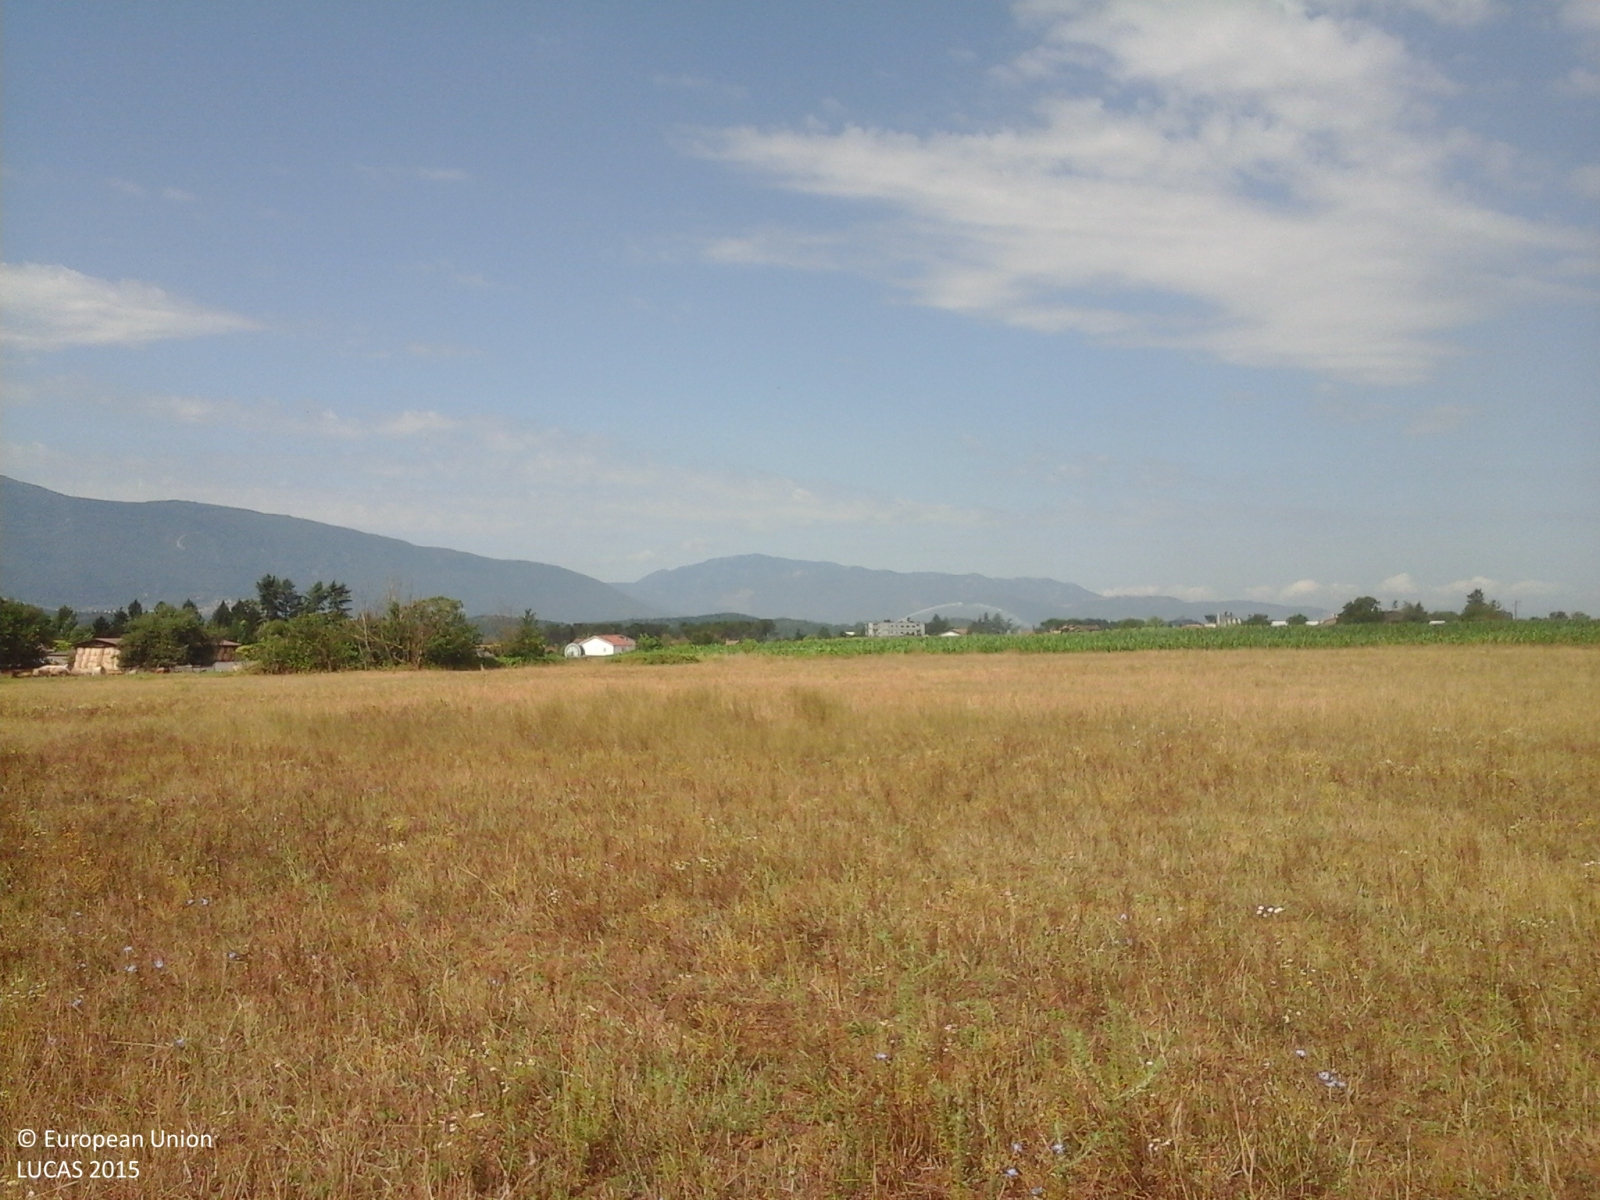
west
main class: Grassland
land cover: Grassland without tree/shrub cover
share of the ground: > 75 %
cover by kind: herbaceous plants 100 %
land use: Agriculture (excluding fallow land and kitchen gardens)
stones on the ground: < 10 %
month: June
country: IT
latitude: 41.7169
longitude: 13.2212
